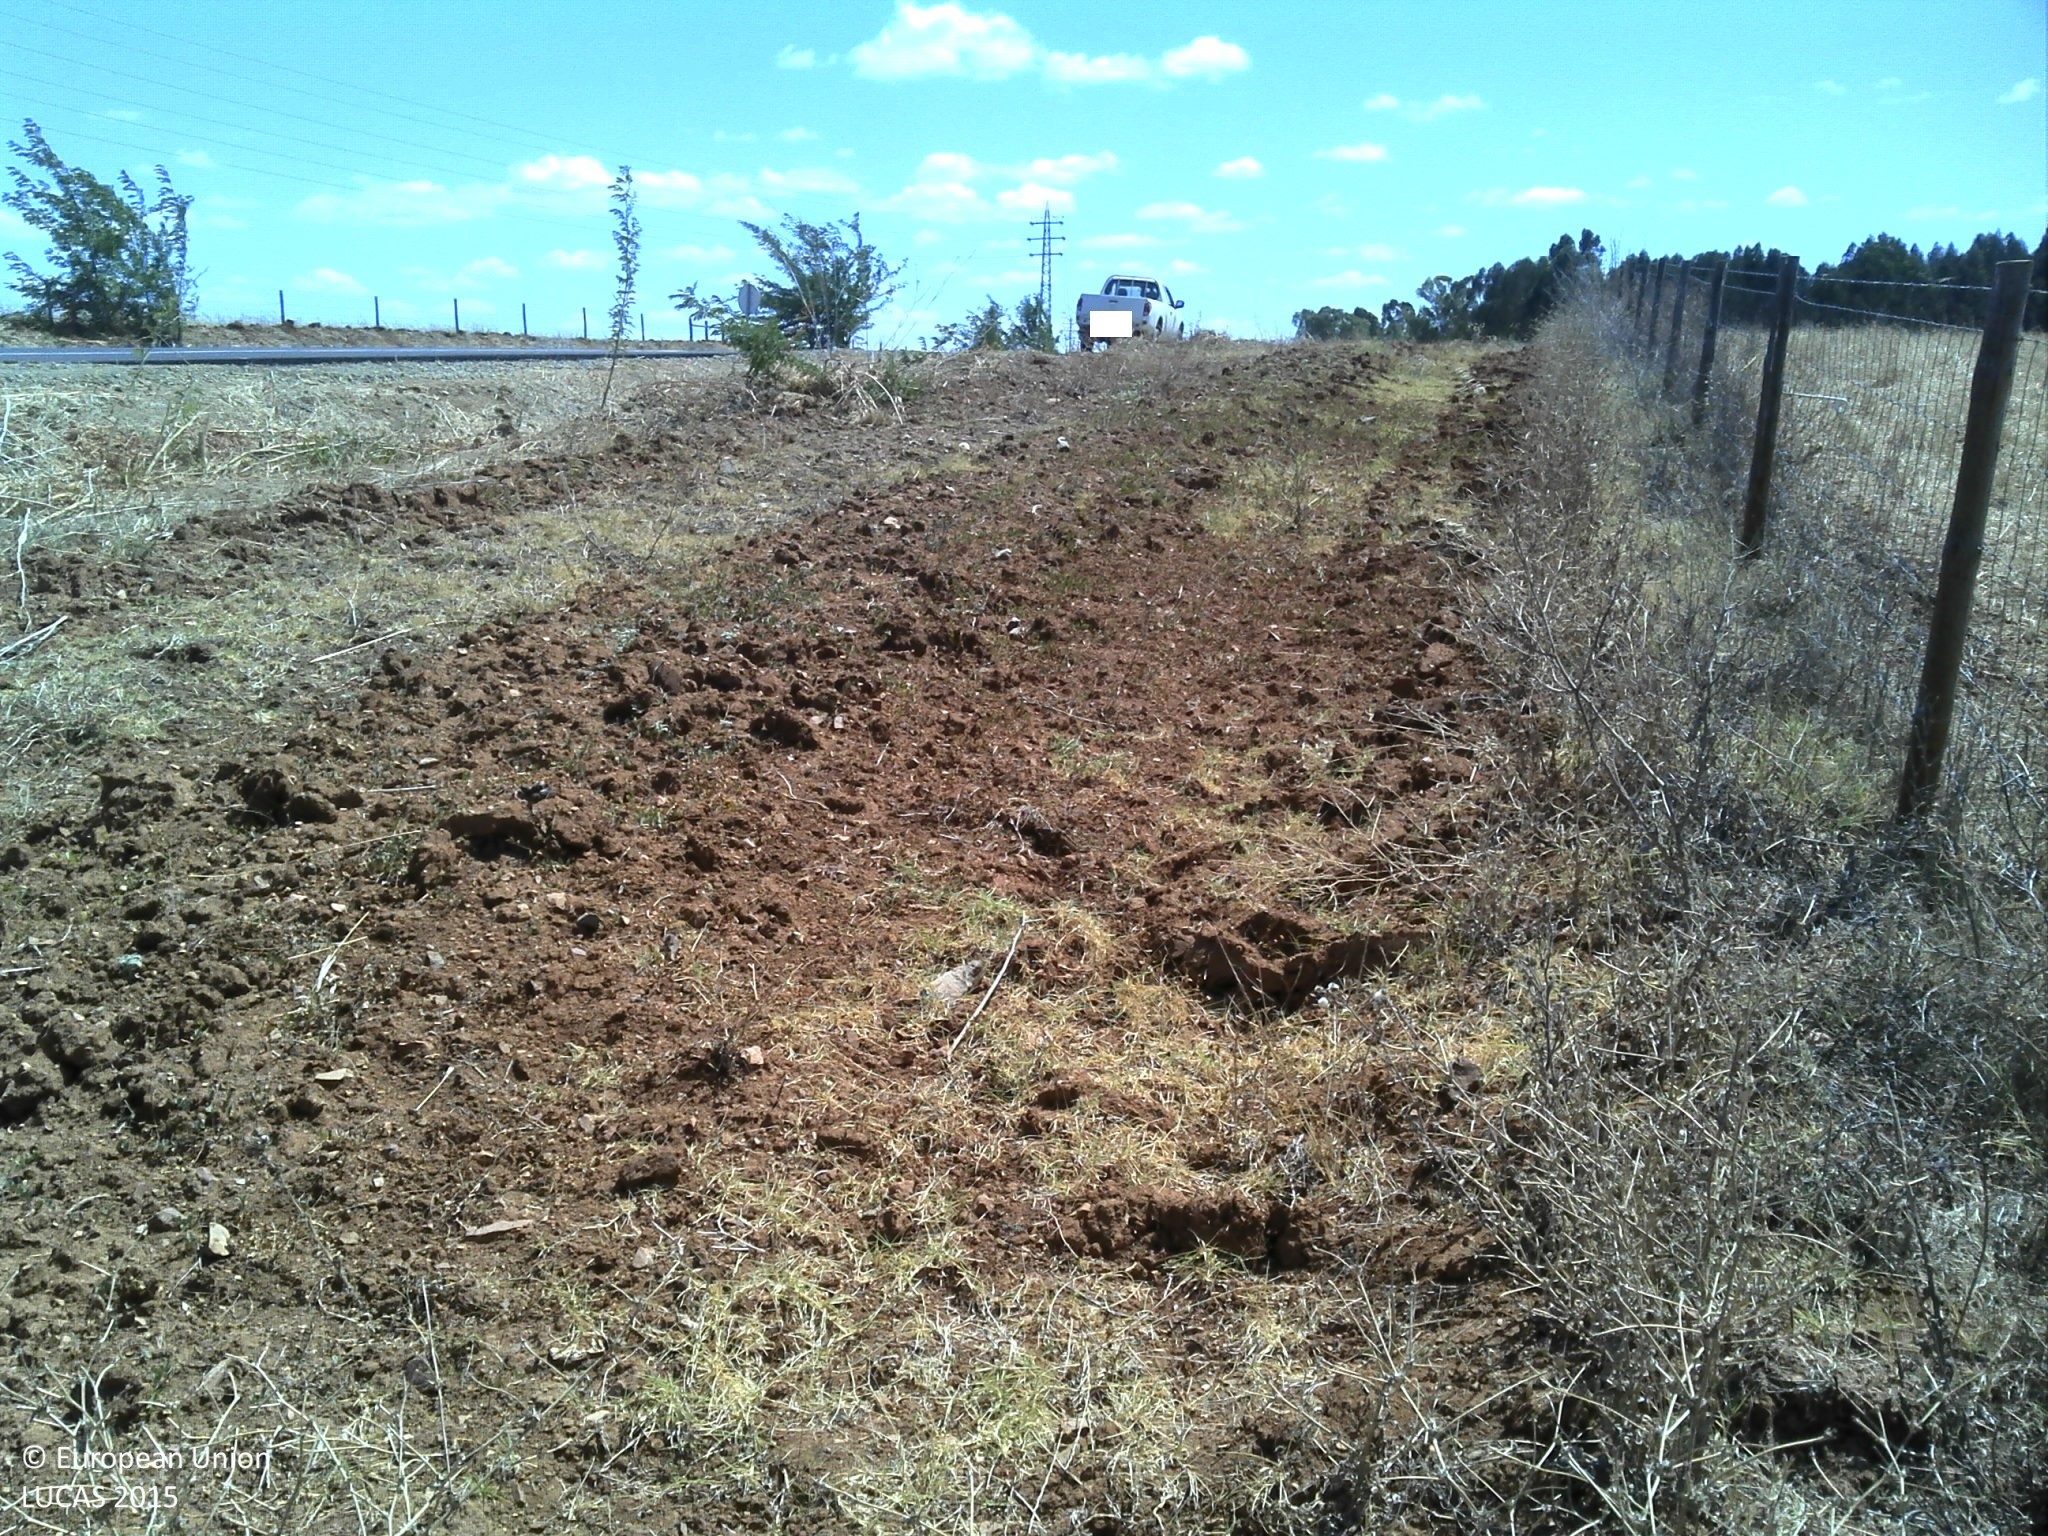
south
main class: Grassland
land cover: Grassland without tree/shrub cover
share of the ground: > 75 %
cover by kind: herbaceous plants 85 %, unconsolidated bare surface 15 %
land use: Agriculture (excluding fallow land and kitchen gardens)
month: July
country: PT
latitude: 38.0755
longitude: -7.8695
